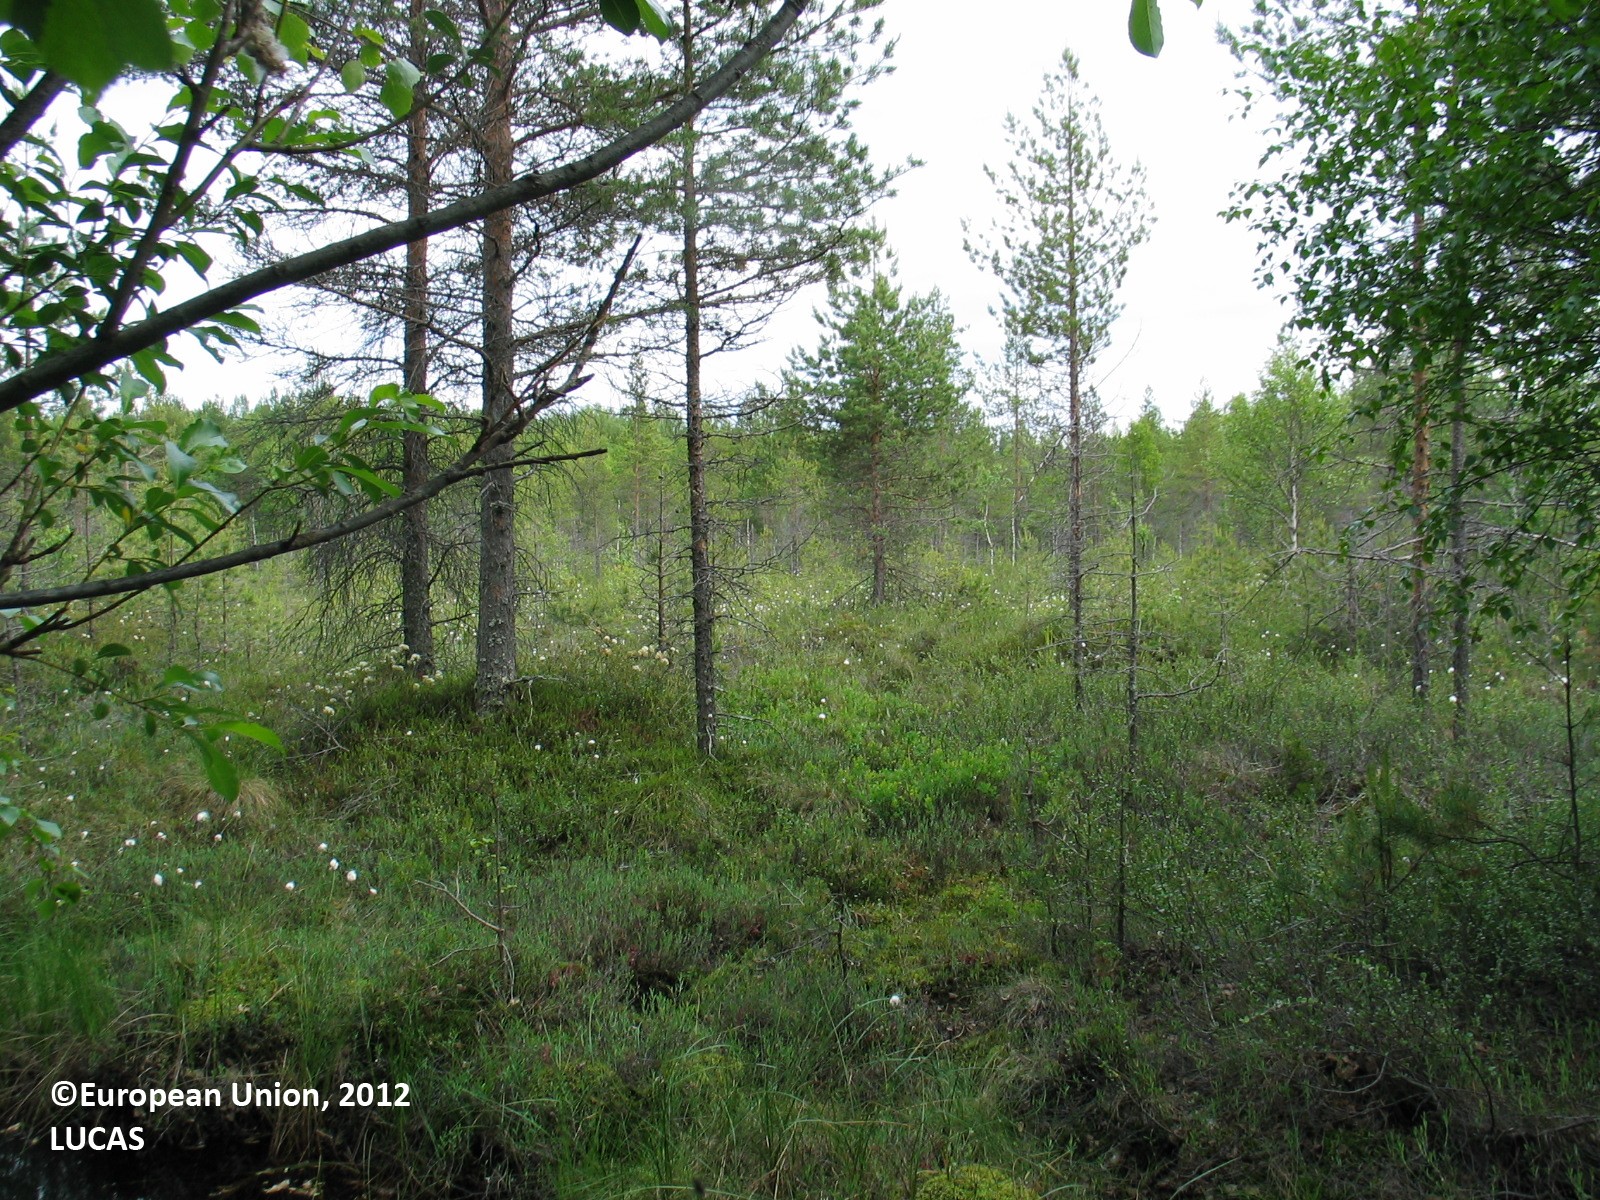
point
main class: Woodland
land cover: Pine dominated coniferous woodland
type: mire and swamp forests
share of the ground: 10 - 25 %
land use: Semi-natural and natural areas not in use
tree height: > 5 m
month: June
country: FI
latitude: 64.8172
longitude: 26.5622
